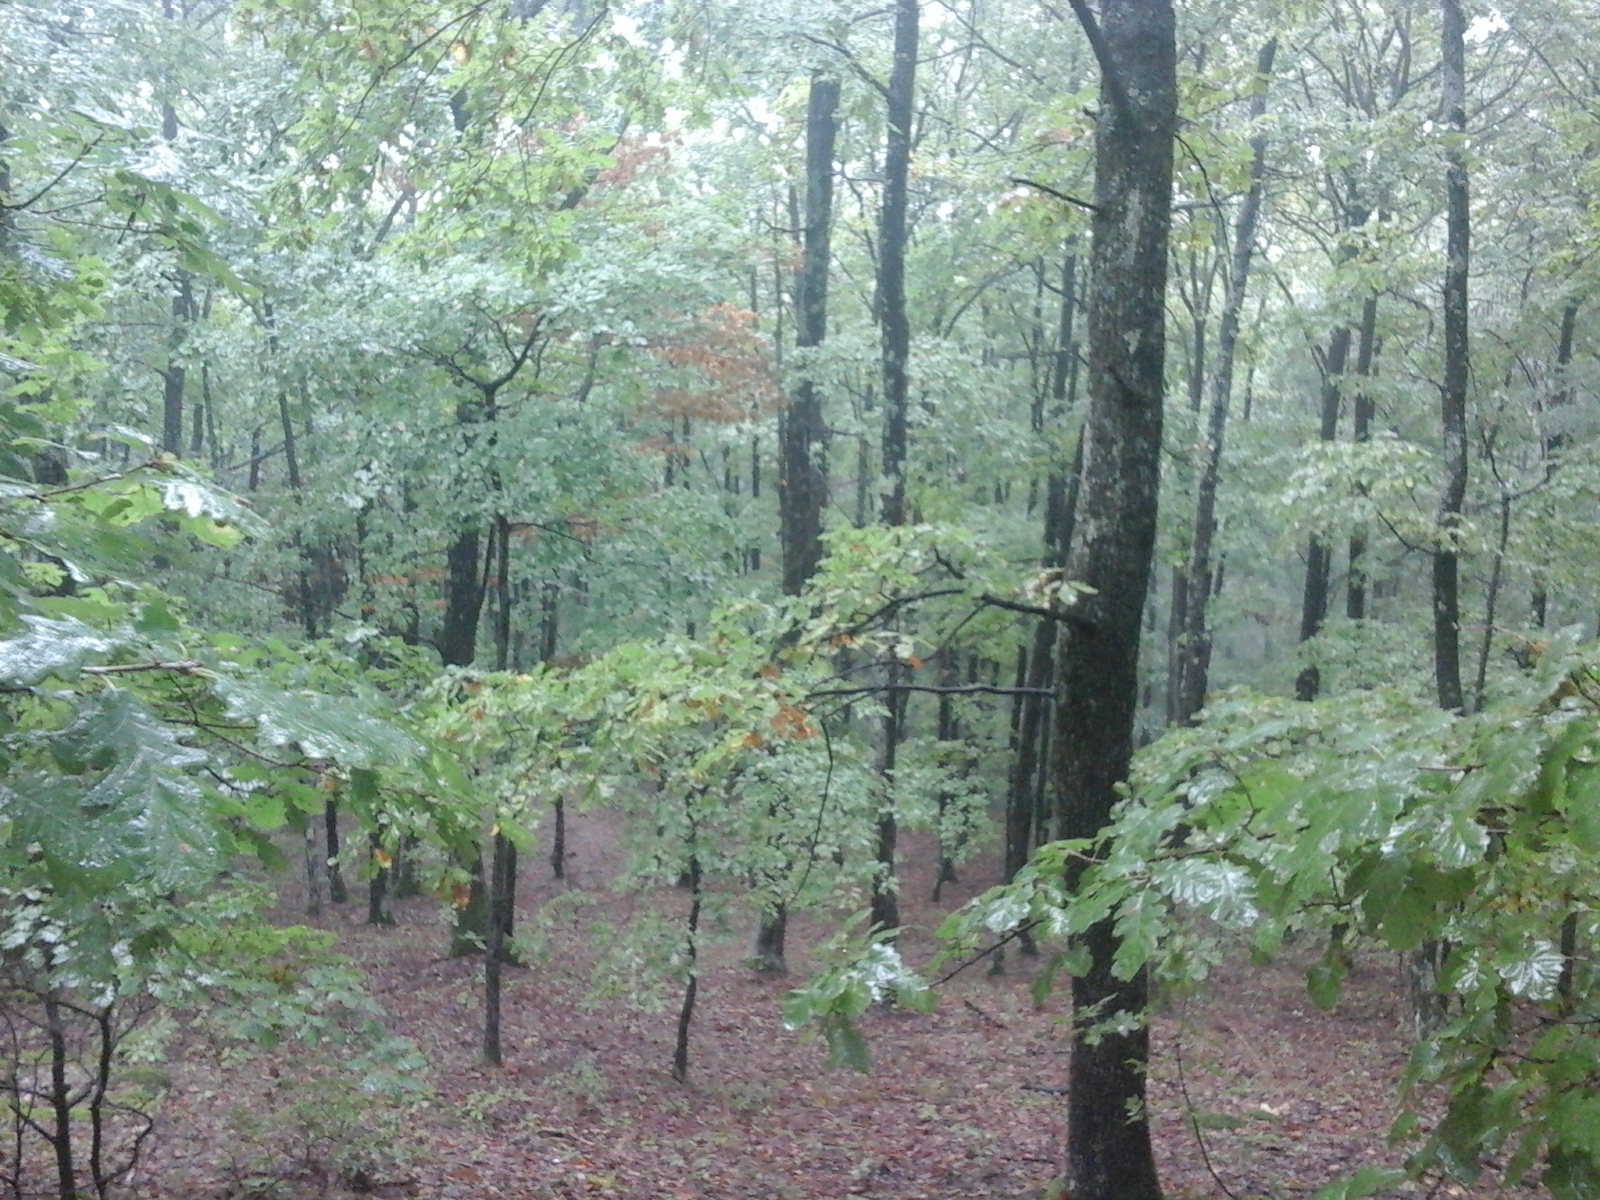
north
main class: Woodland
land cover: Broadleaved woodland
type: acidophilous oak and oak-birch forest
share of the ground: > 75 %
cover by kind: broadleaved forest trees 100 %
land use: Forestry
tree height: > 5 m
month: September
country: RO
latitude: 44.9308
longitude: 23.7323
